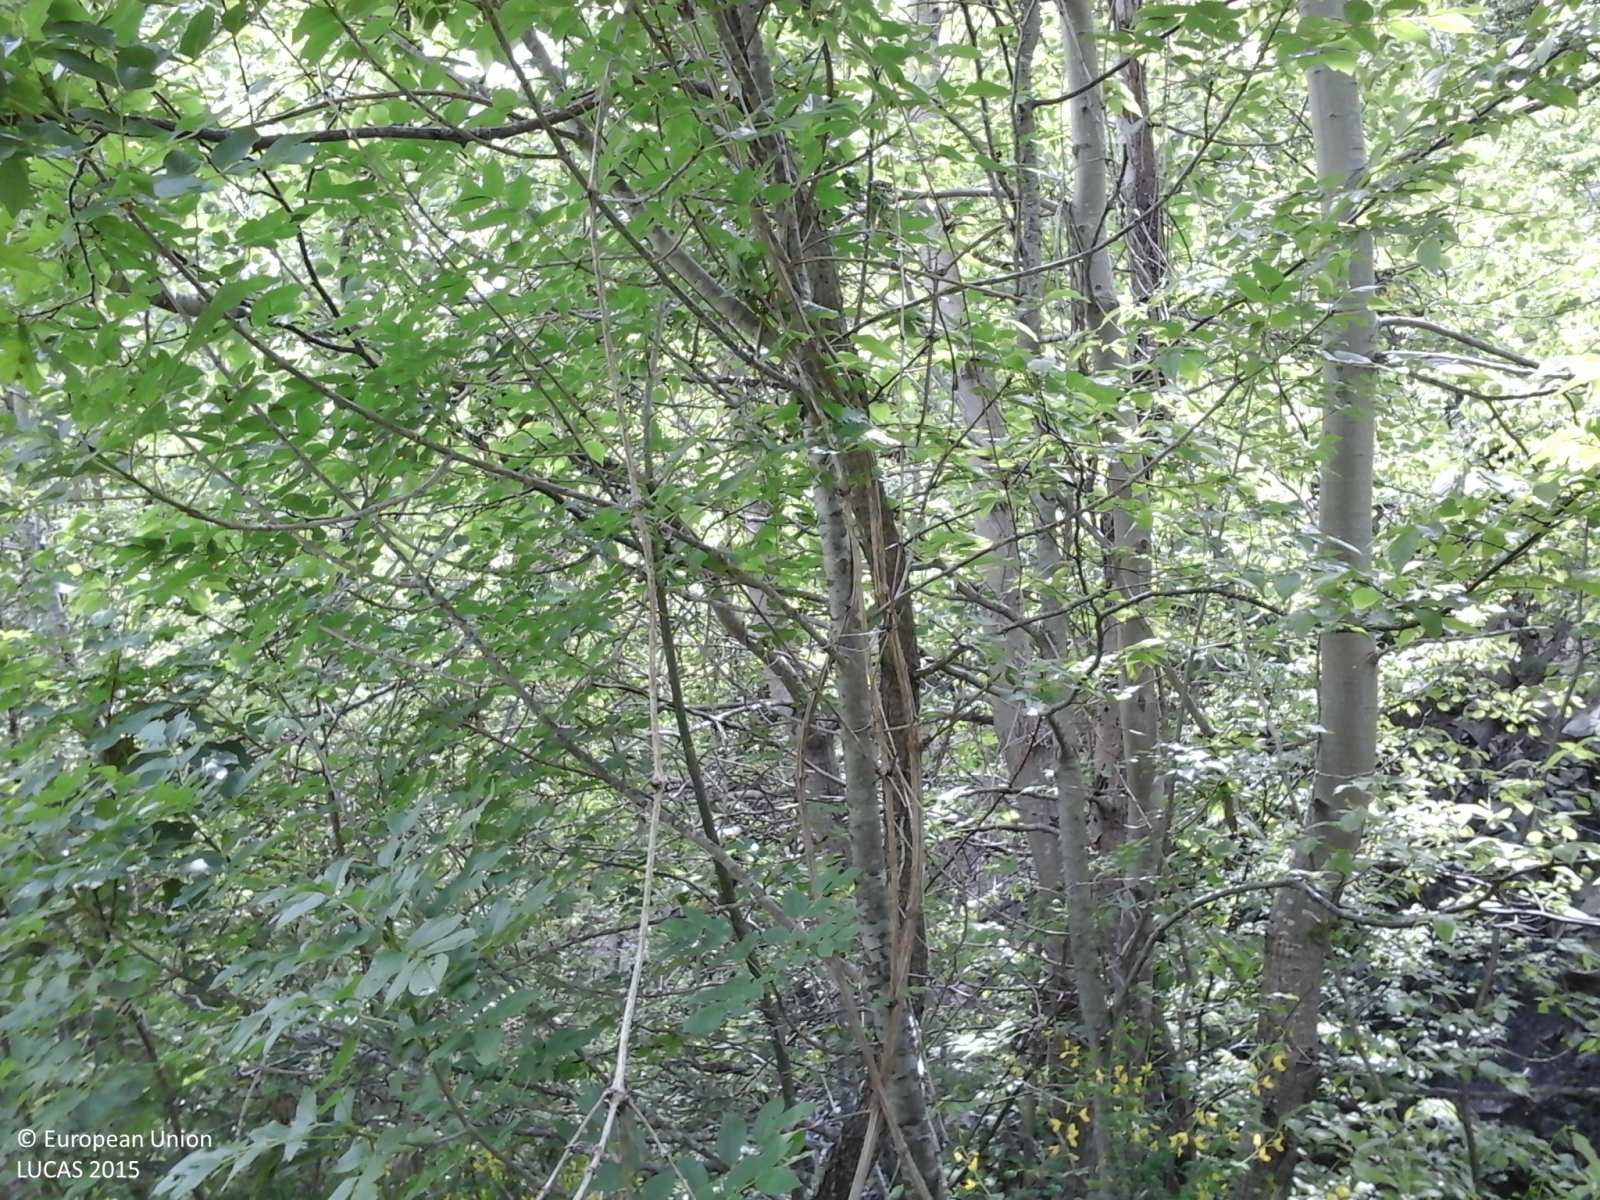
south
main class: Woodland
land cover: Broadleaved woodland
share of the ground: > 75 %
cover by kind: broadleaved forest trees 85 %, shrubs 15 %
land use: Forestry
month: May
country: IT
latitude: 44.5127
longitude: 10.1632
